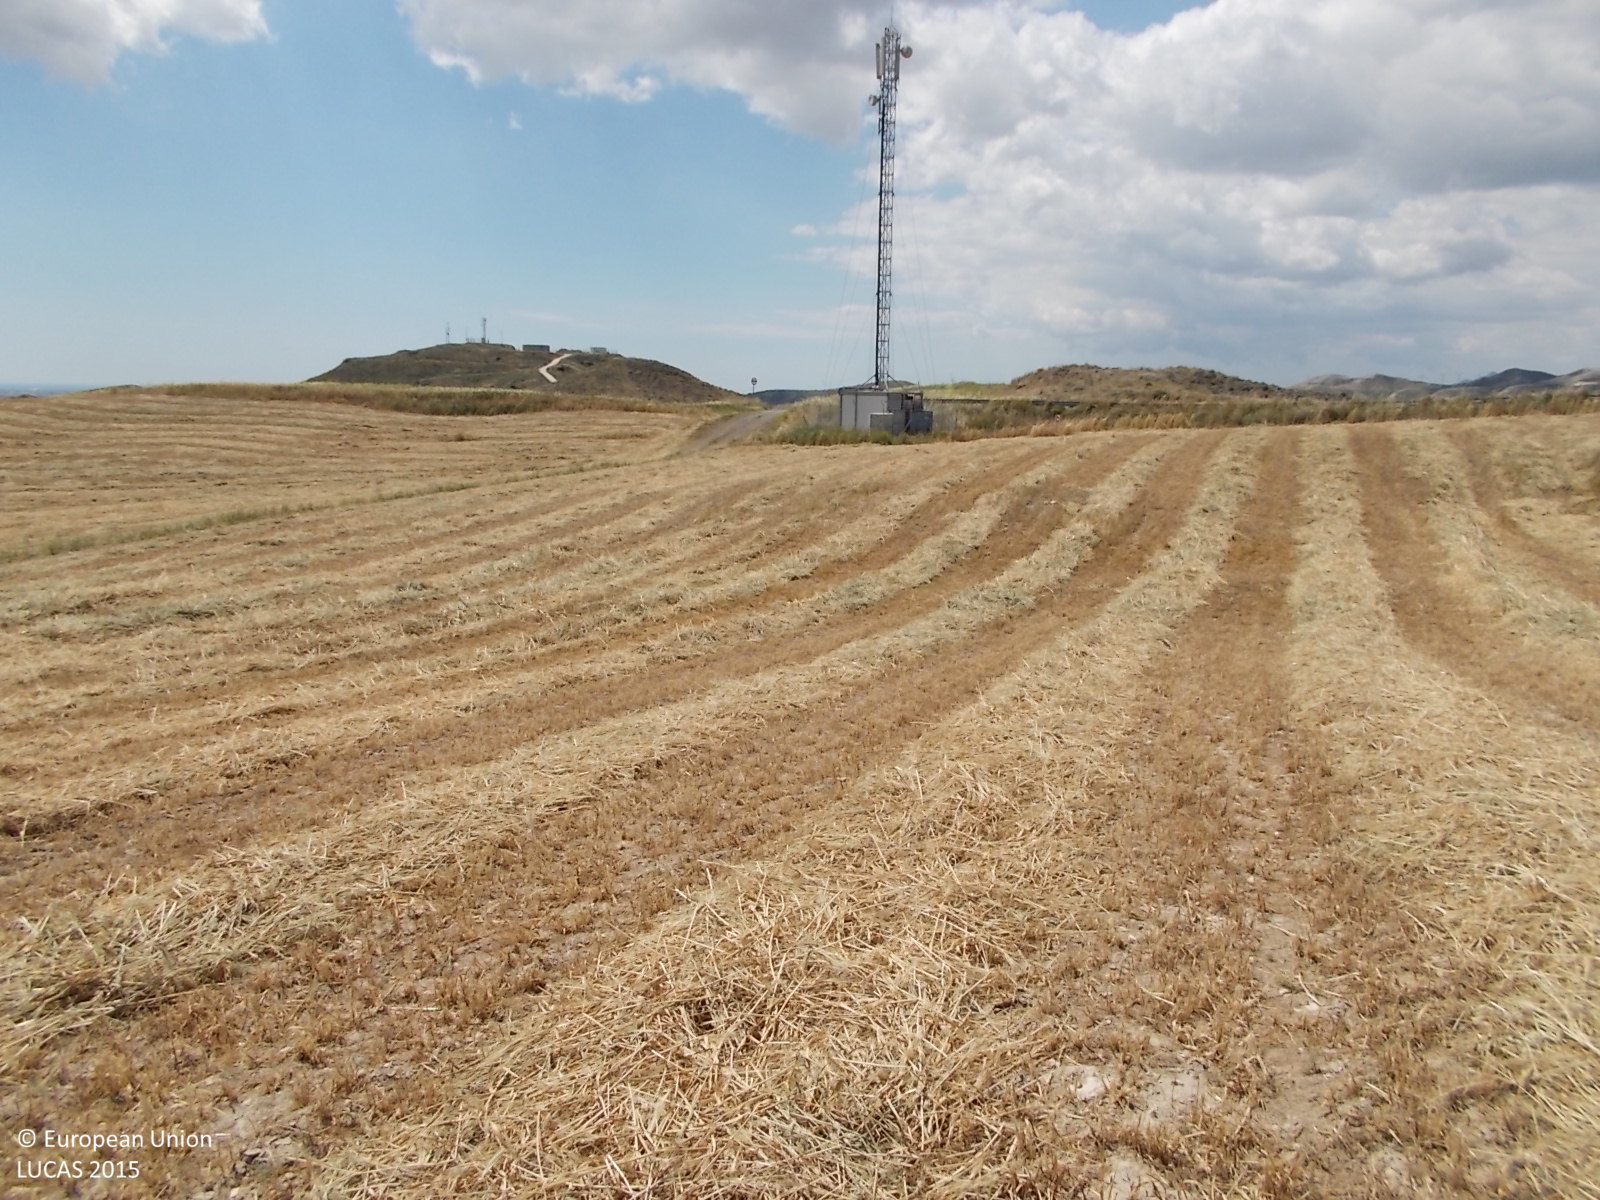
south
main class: Cropland
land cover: Mixed cereals for fodder
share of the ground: < 10 %
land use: Agriculture (excluding fallow land and kitchen gardens)
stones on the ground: < 10 %
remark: Harvested field
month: April
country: CY
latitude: 35.0207
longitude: 33.5744
